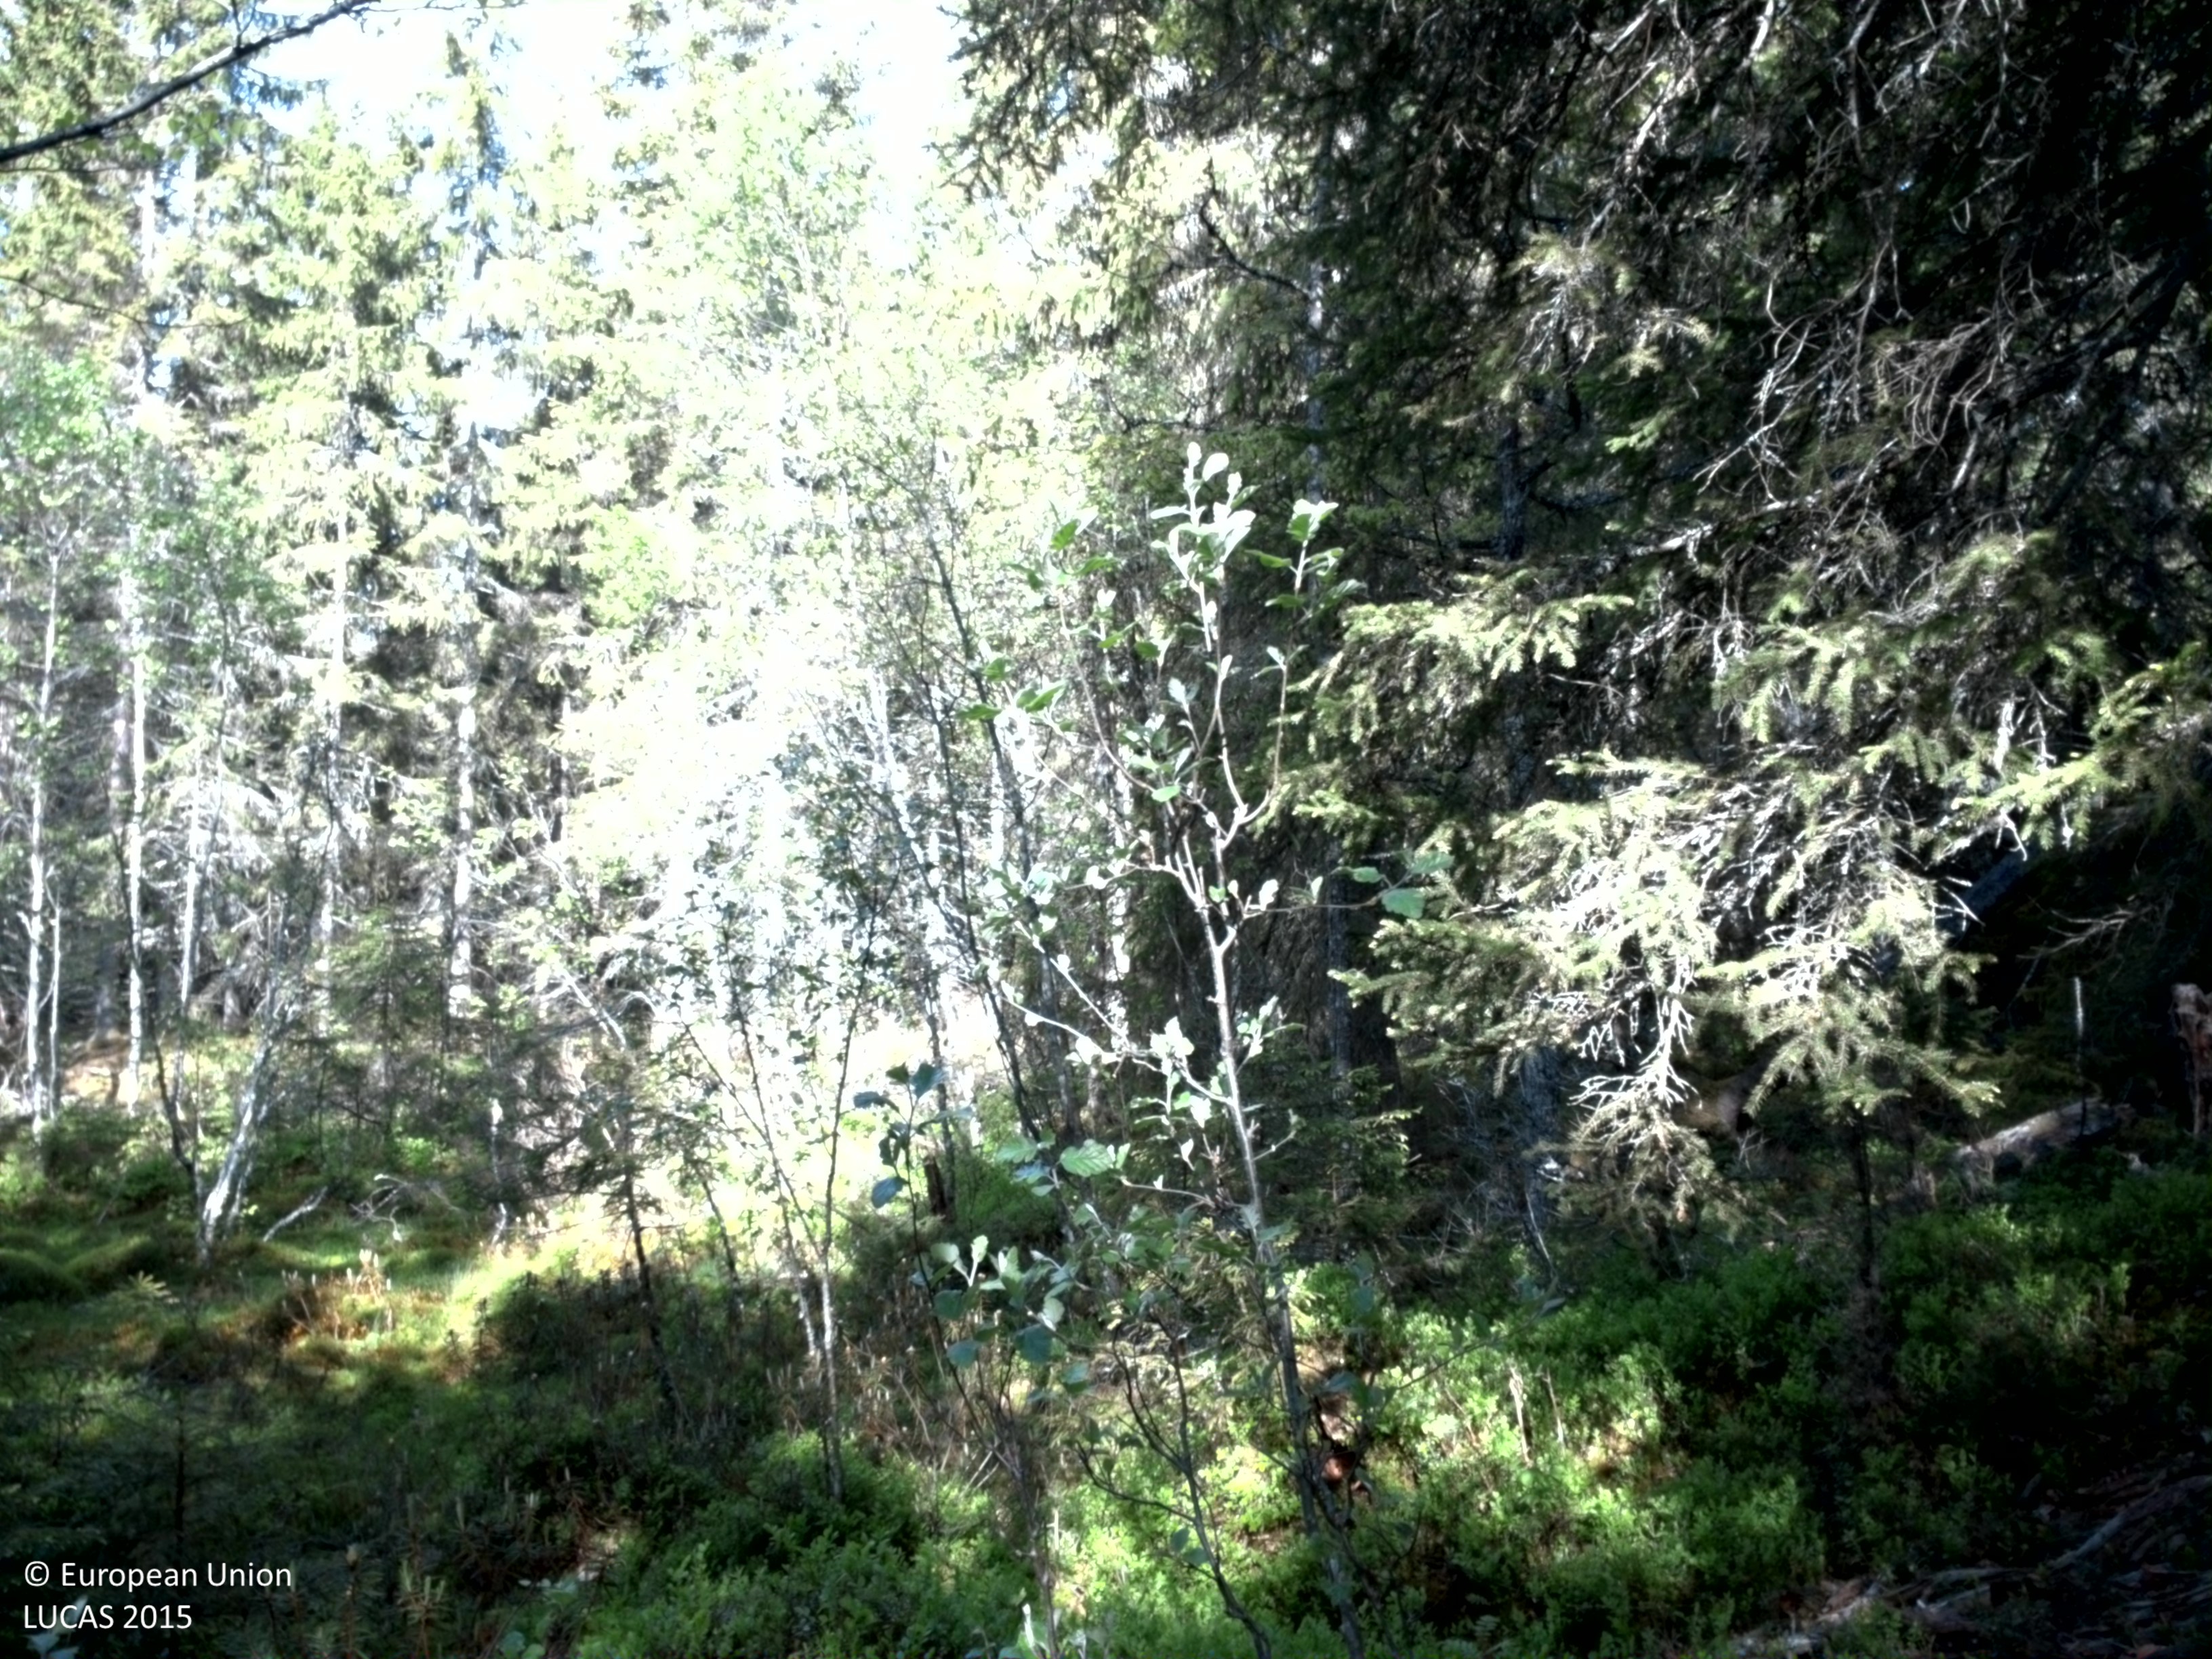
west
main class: Woodland
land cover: Spruce dominated coniferous woodland
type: boreal forest
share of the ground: 50 - 75 %
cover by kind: coniferous forest trees 40 %, lichens and mosses 30 %, shrubs 15 %, broadleaved forest trees 10 %, herbaceous plants 5 %
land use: Forestry
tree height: > 5 m
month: May
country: SE
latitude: 57.3705
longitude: 15.4345
